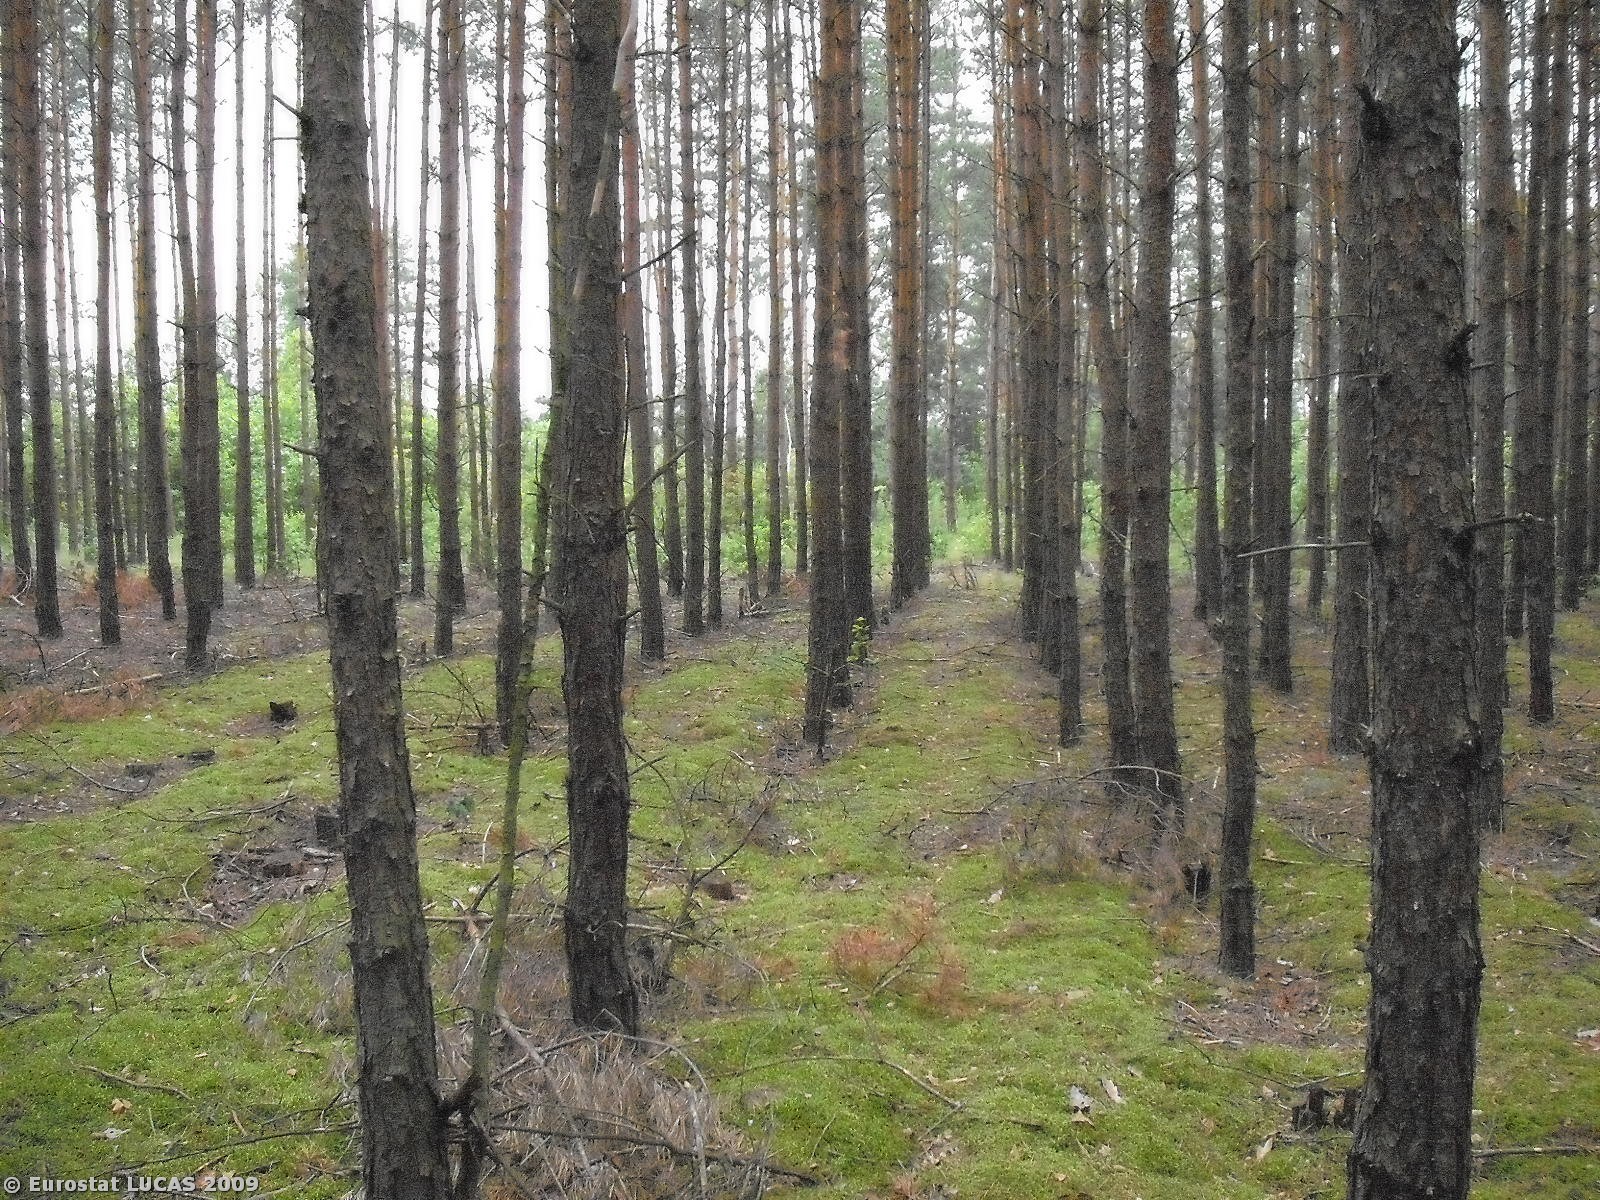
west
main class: Woodland
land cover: Coniferous woodland
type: hemiboreal forest and nemoral coniferous forest and mixed broadleaved-coniferous forest
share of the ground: > 75 %
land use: Forestry
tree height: > 5 m
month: June
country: PL
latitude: 51.4111
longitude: 20.6071
